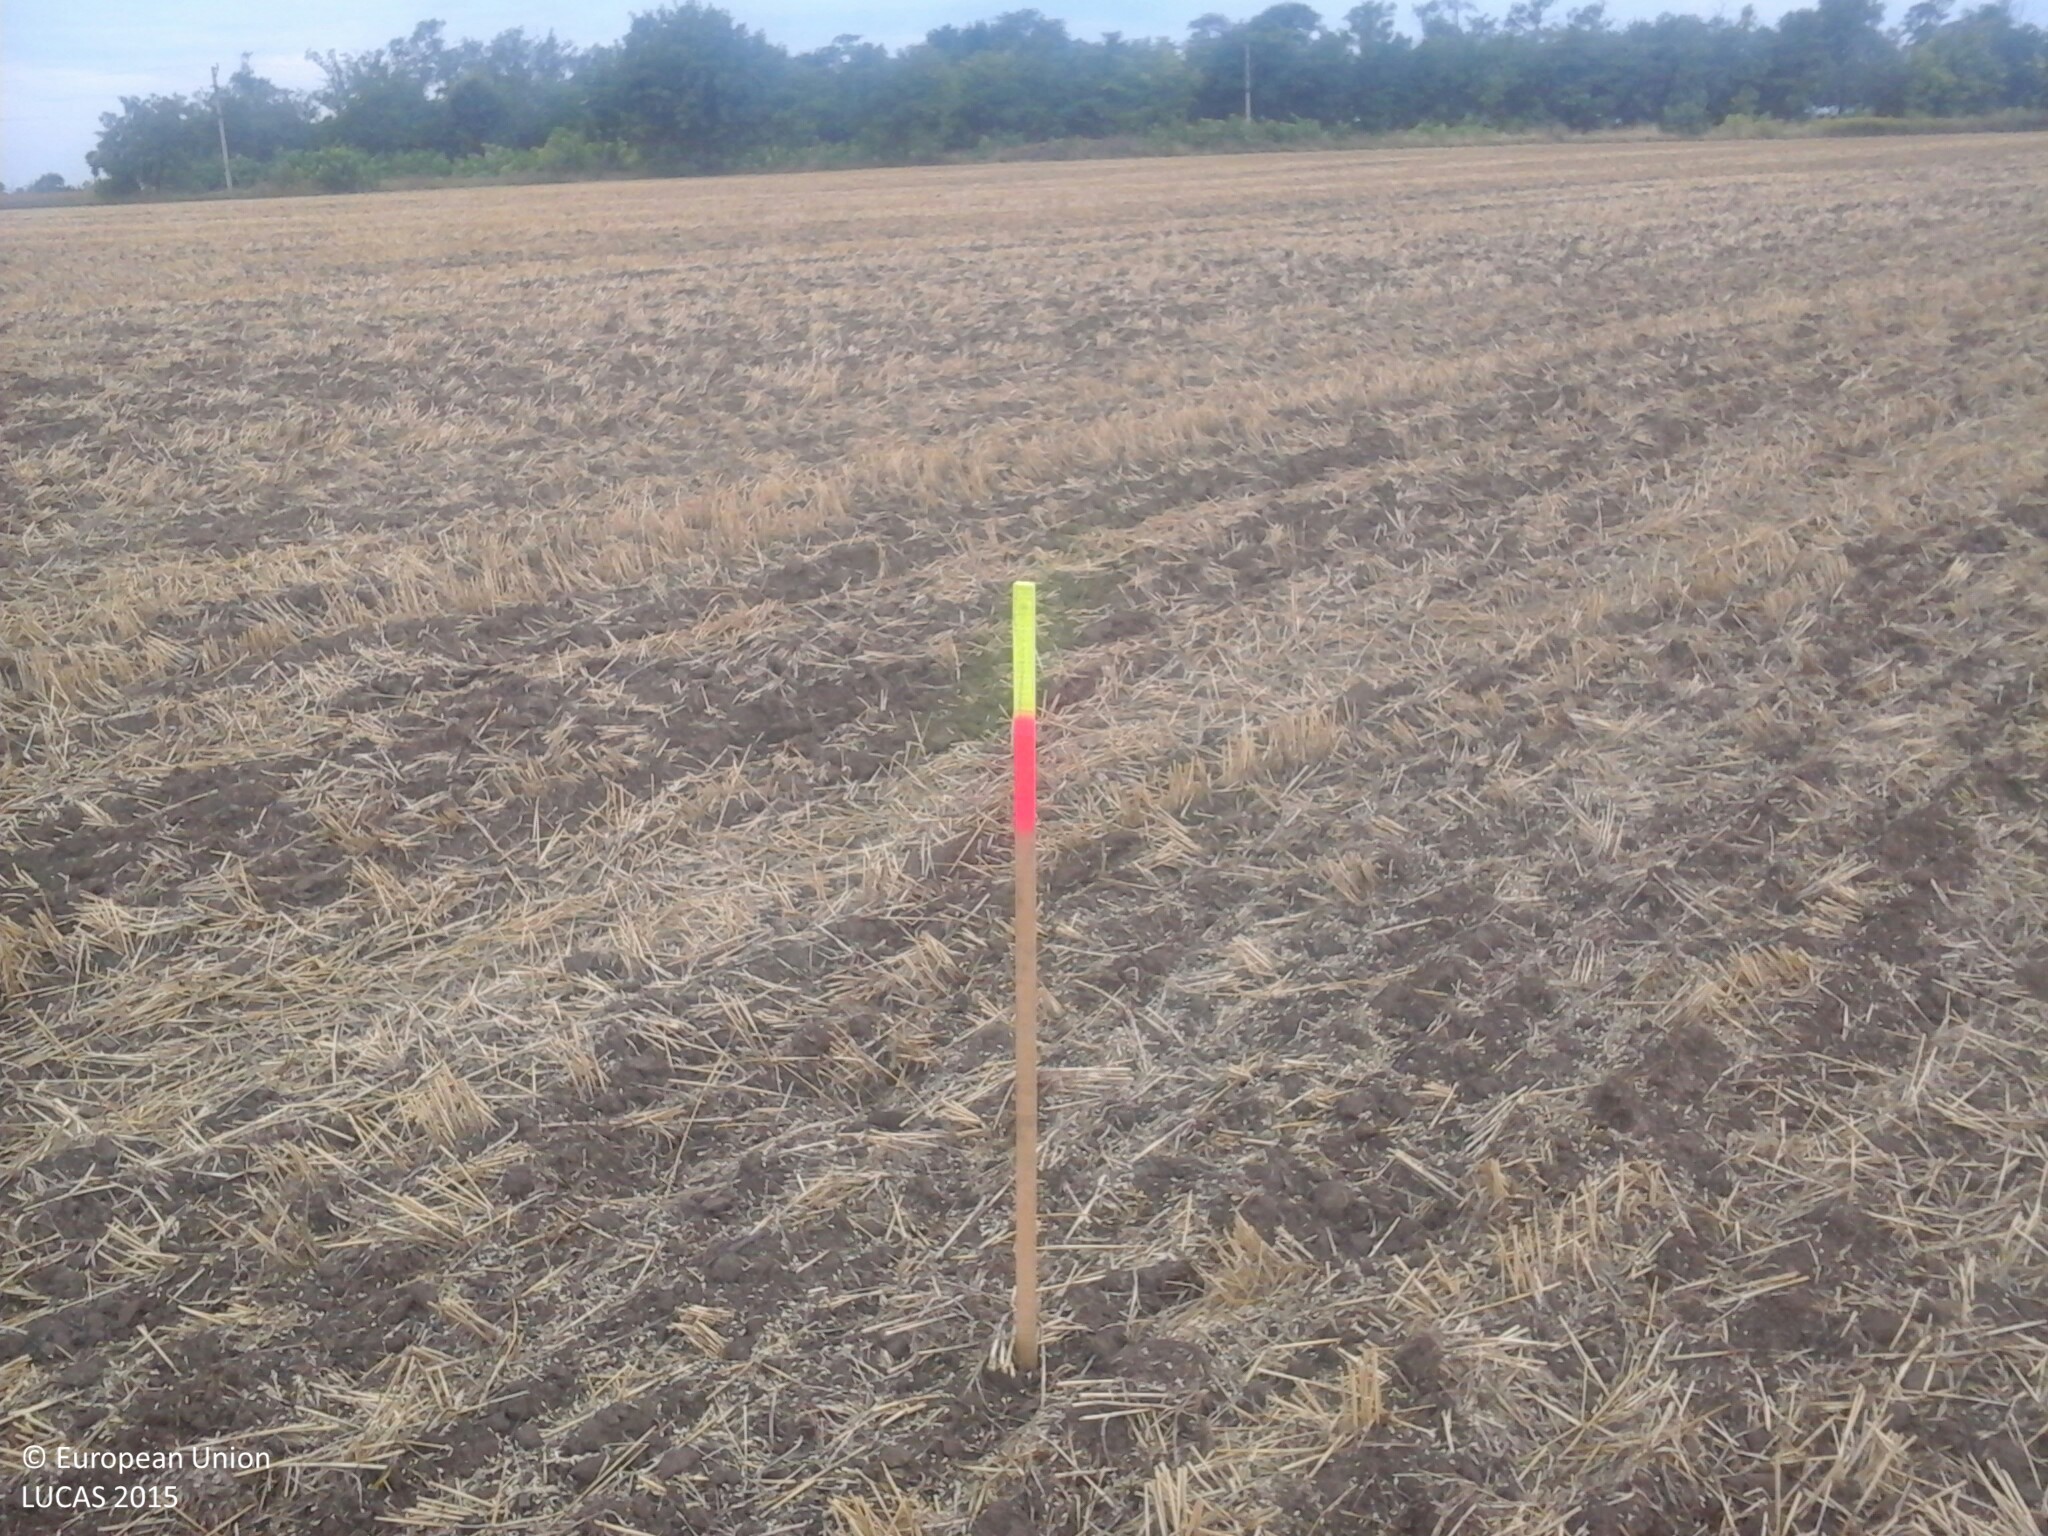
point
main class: Cropland
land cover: Oats
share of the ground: < 10 %
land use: Agriculture (excluding fallow land and kitchen gardens)
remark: Harvested field
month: July
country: HU
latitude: 47.0723
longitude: 18.3738
